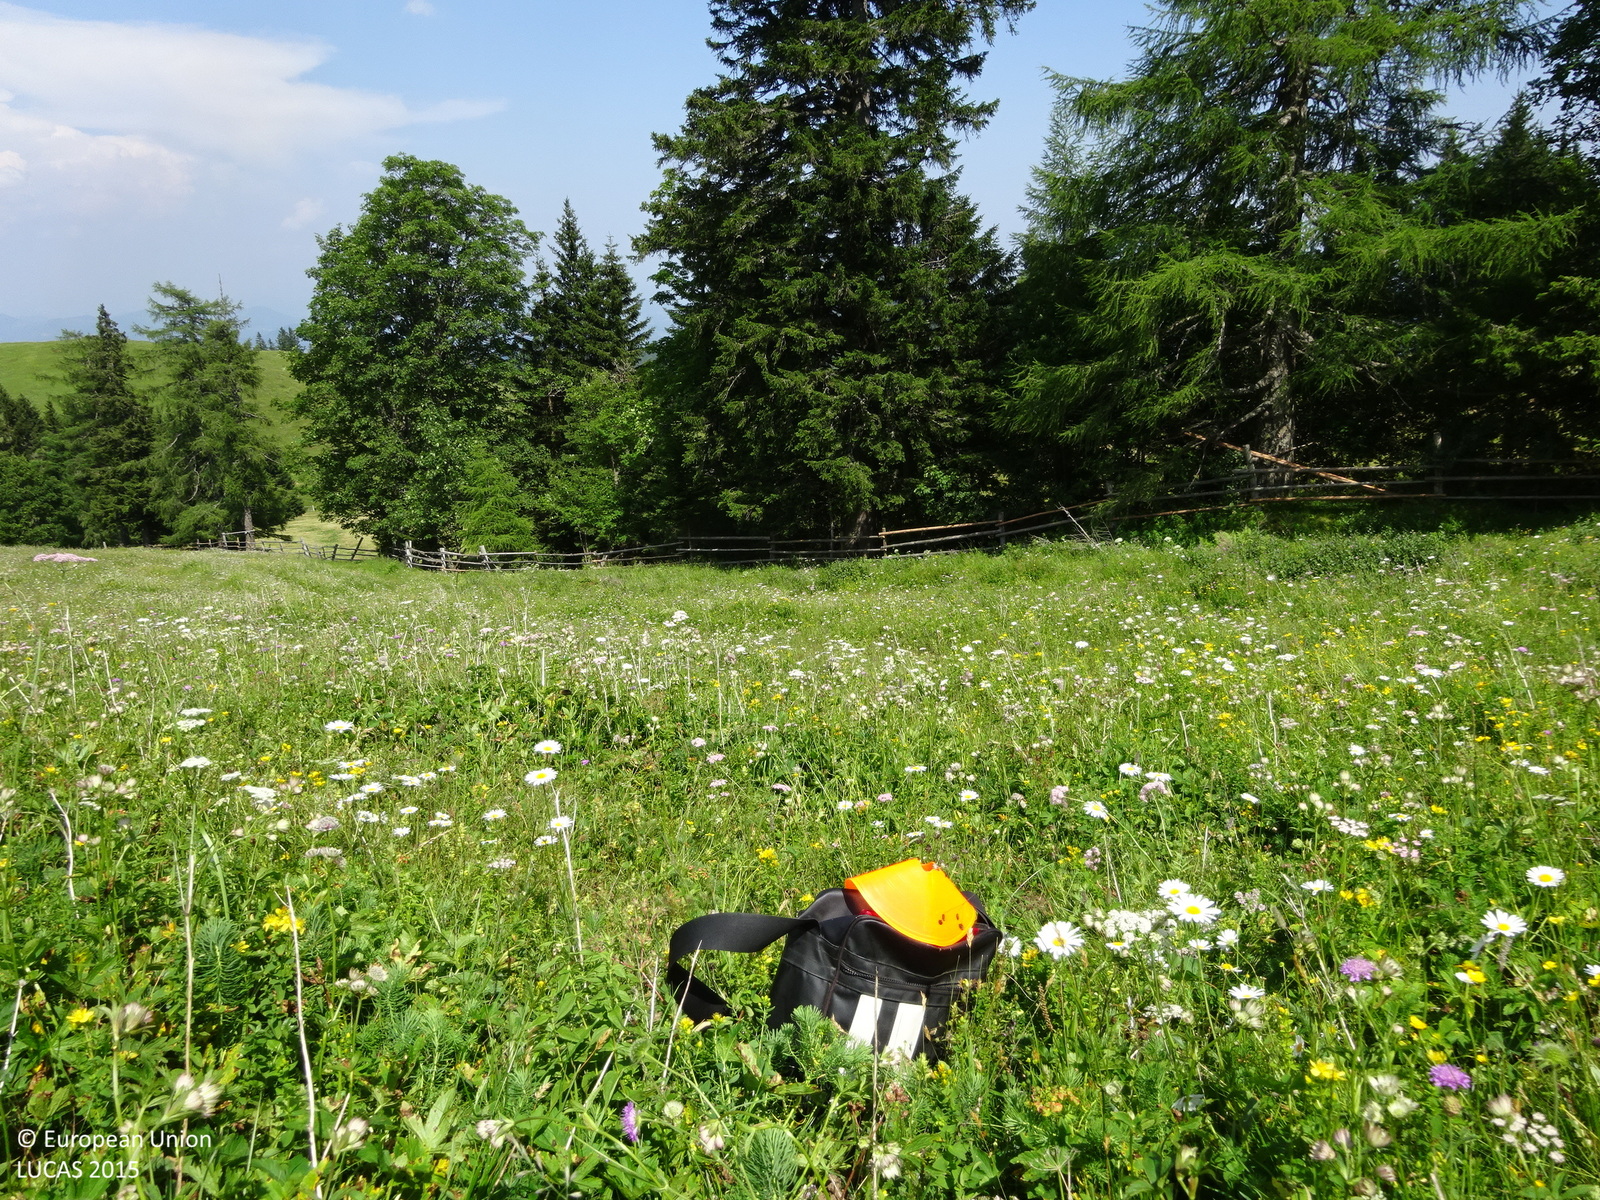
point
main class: Grassland
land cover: Grassland without tree/shrub cover
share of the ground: > 75 %
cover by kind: herbaceous plants 100 %
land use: Agriculture (excluding fallow land and kitchen gardens)
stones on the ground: < 10 %
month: July
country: AT
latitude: 47.0851
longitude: 14.9385
